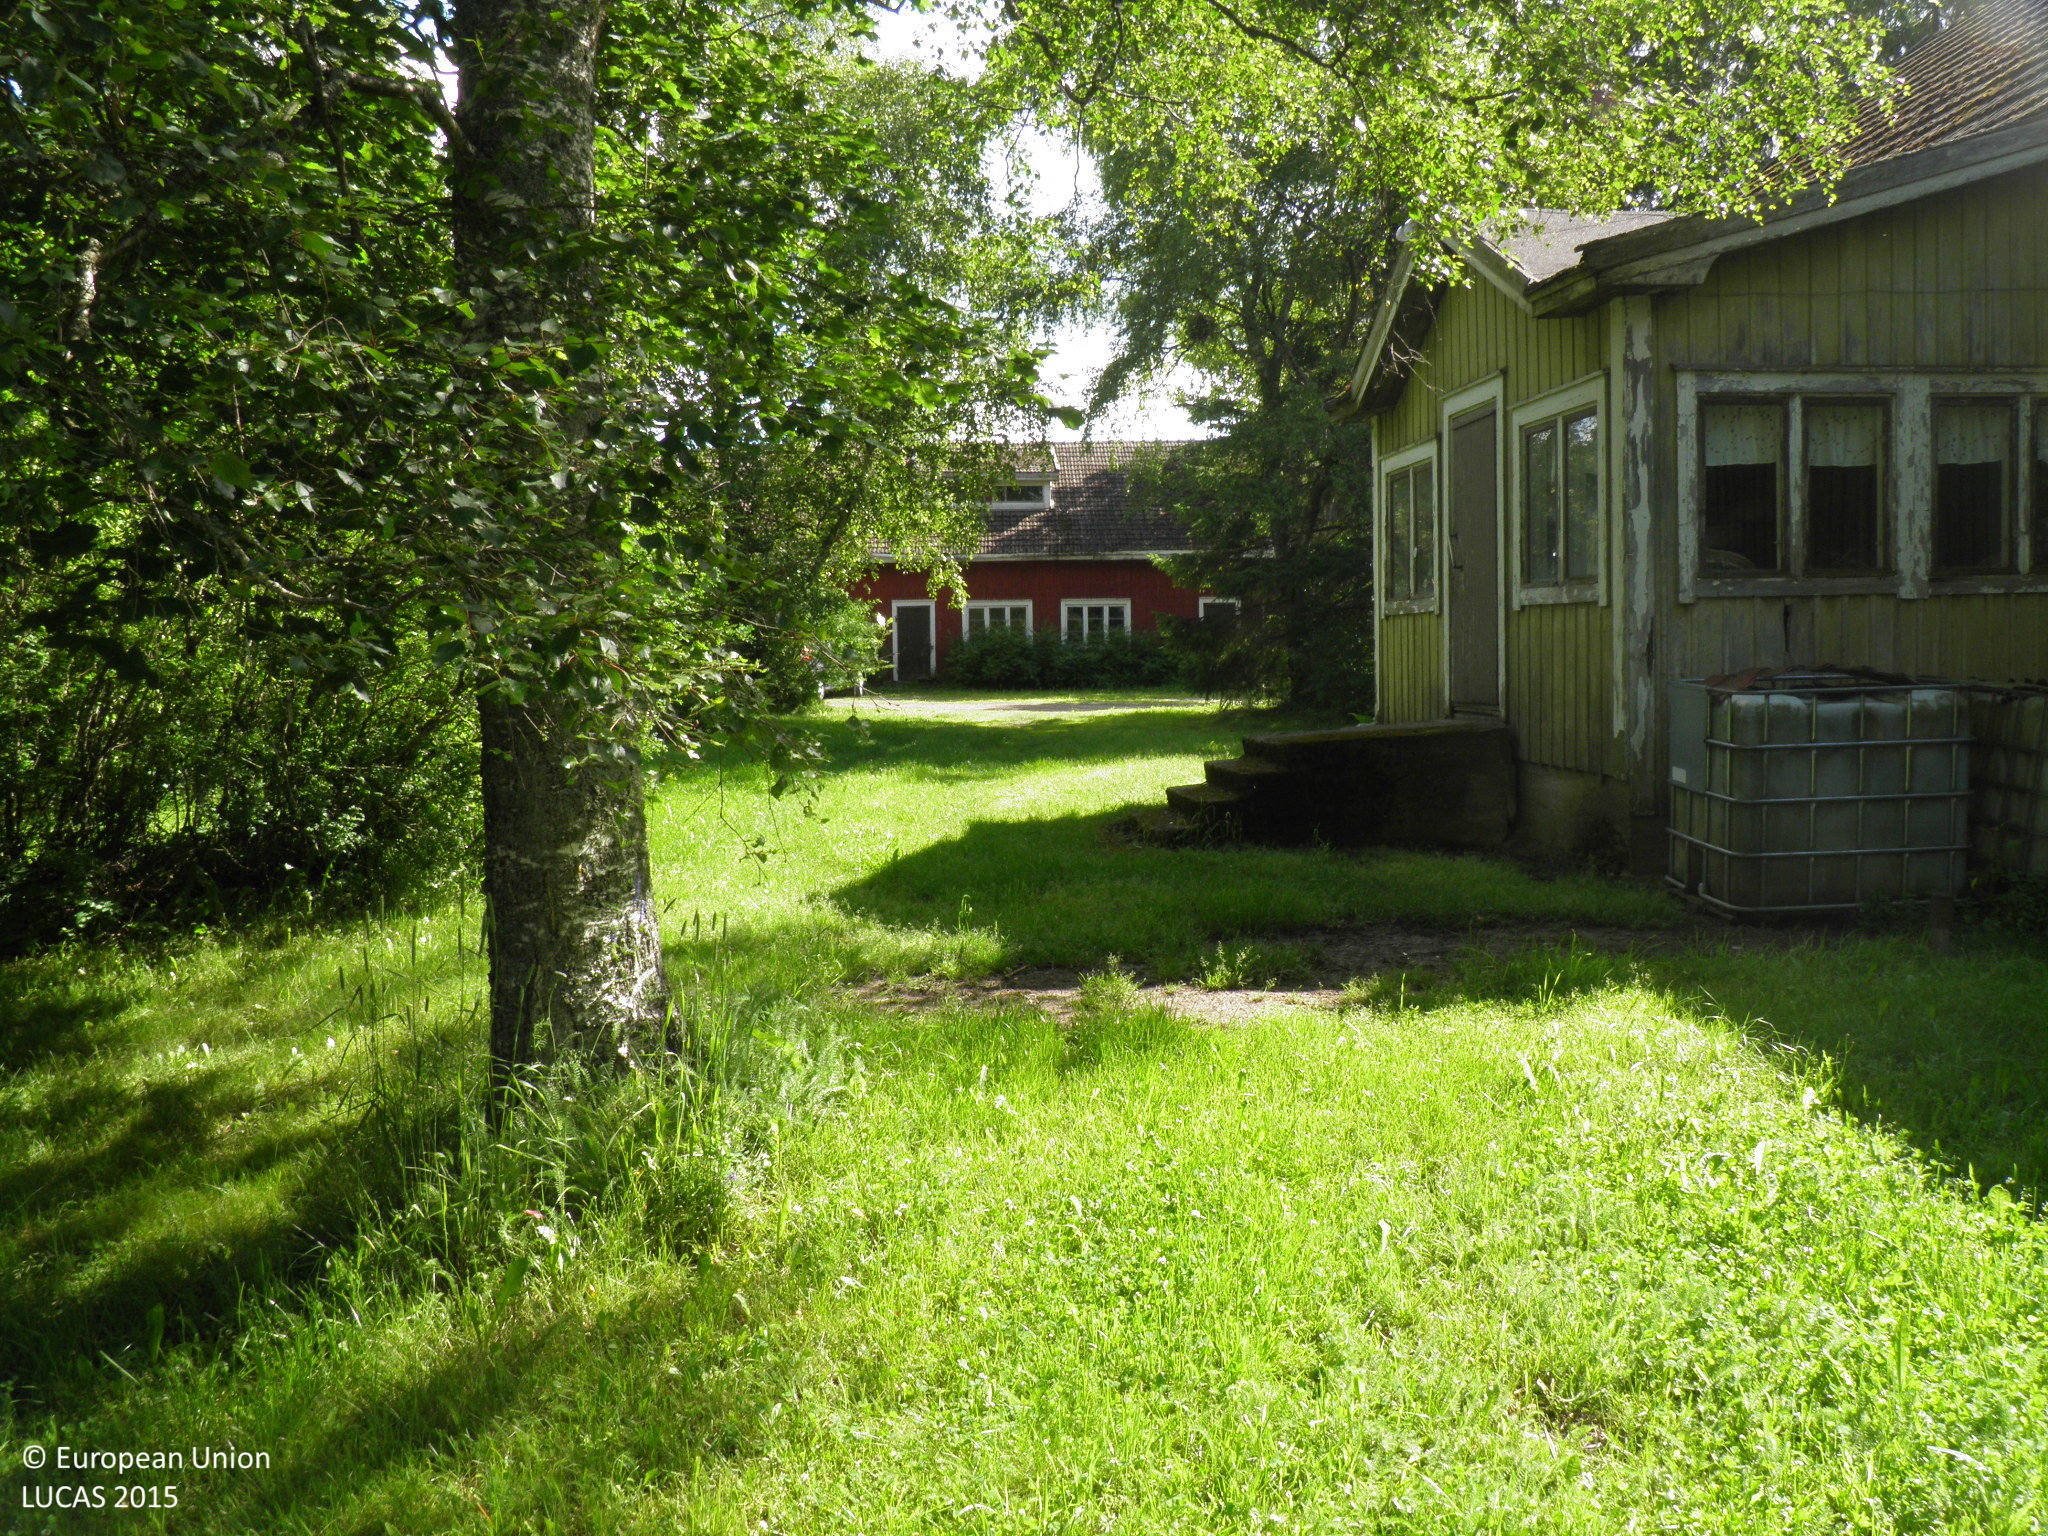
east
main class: Grassland
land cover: Grassland with sparse tree/shrub cover
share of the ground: > 75 %
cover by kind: herbaceous plants 95 %, broadleaved forest trees 5 %
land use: Residential
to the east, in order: Grassland with sparse tree/shrub cover; Artificial constructions in urban areas; Grass margins; Ditches and canals; Grass margins; Common wheat; Electric lines; Common wheat; Grass margins; Ditches and canals; Grass margins; Common wheat; Grass margins; Ditches and canals; Grass margins; Other bare soil
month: July
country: FI
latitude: 60.7904
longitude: 22.9154
